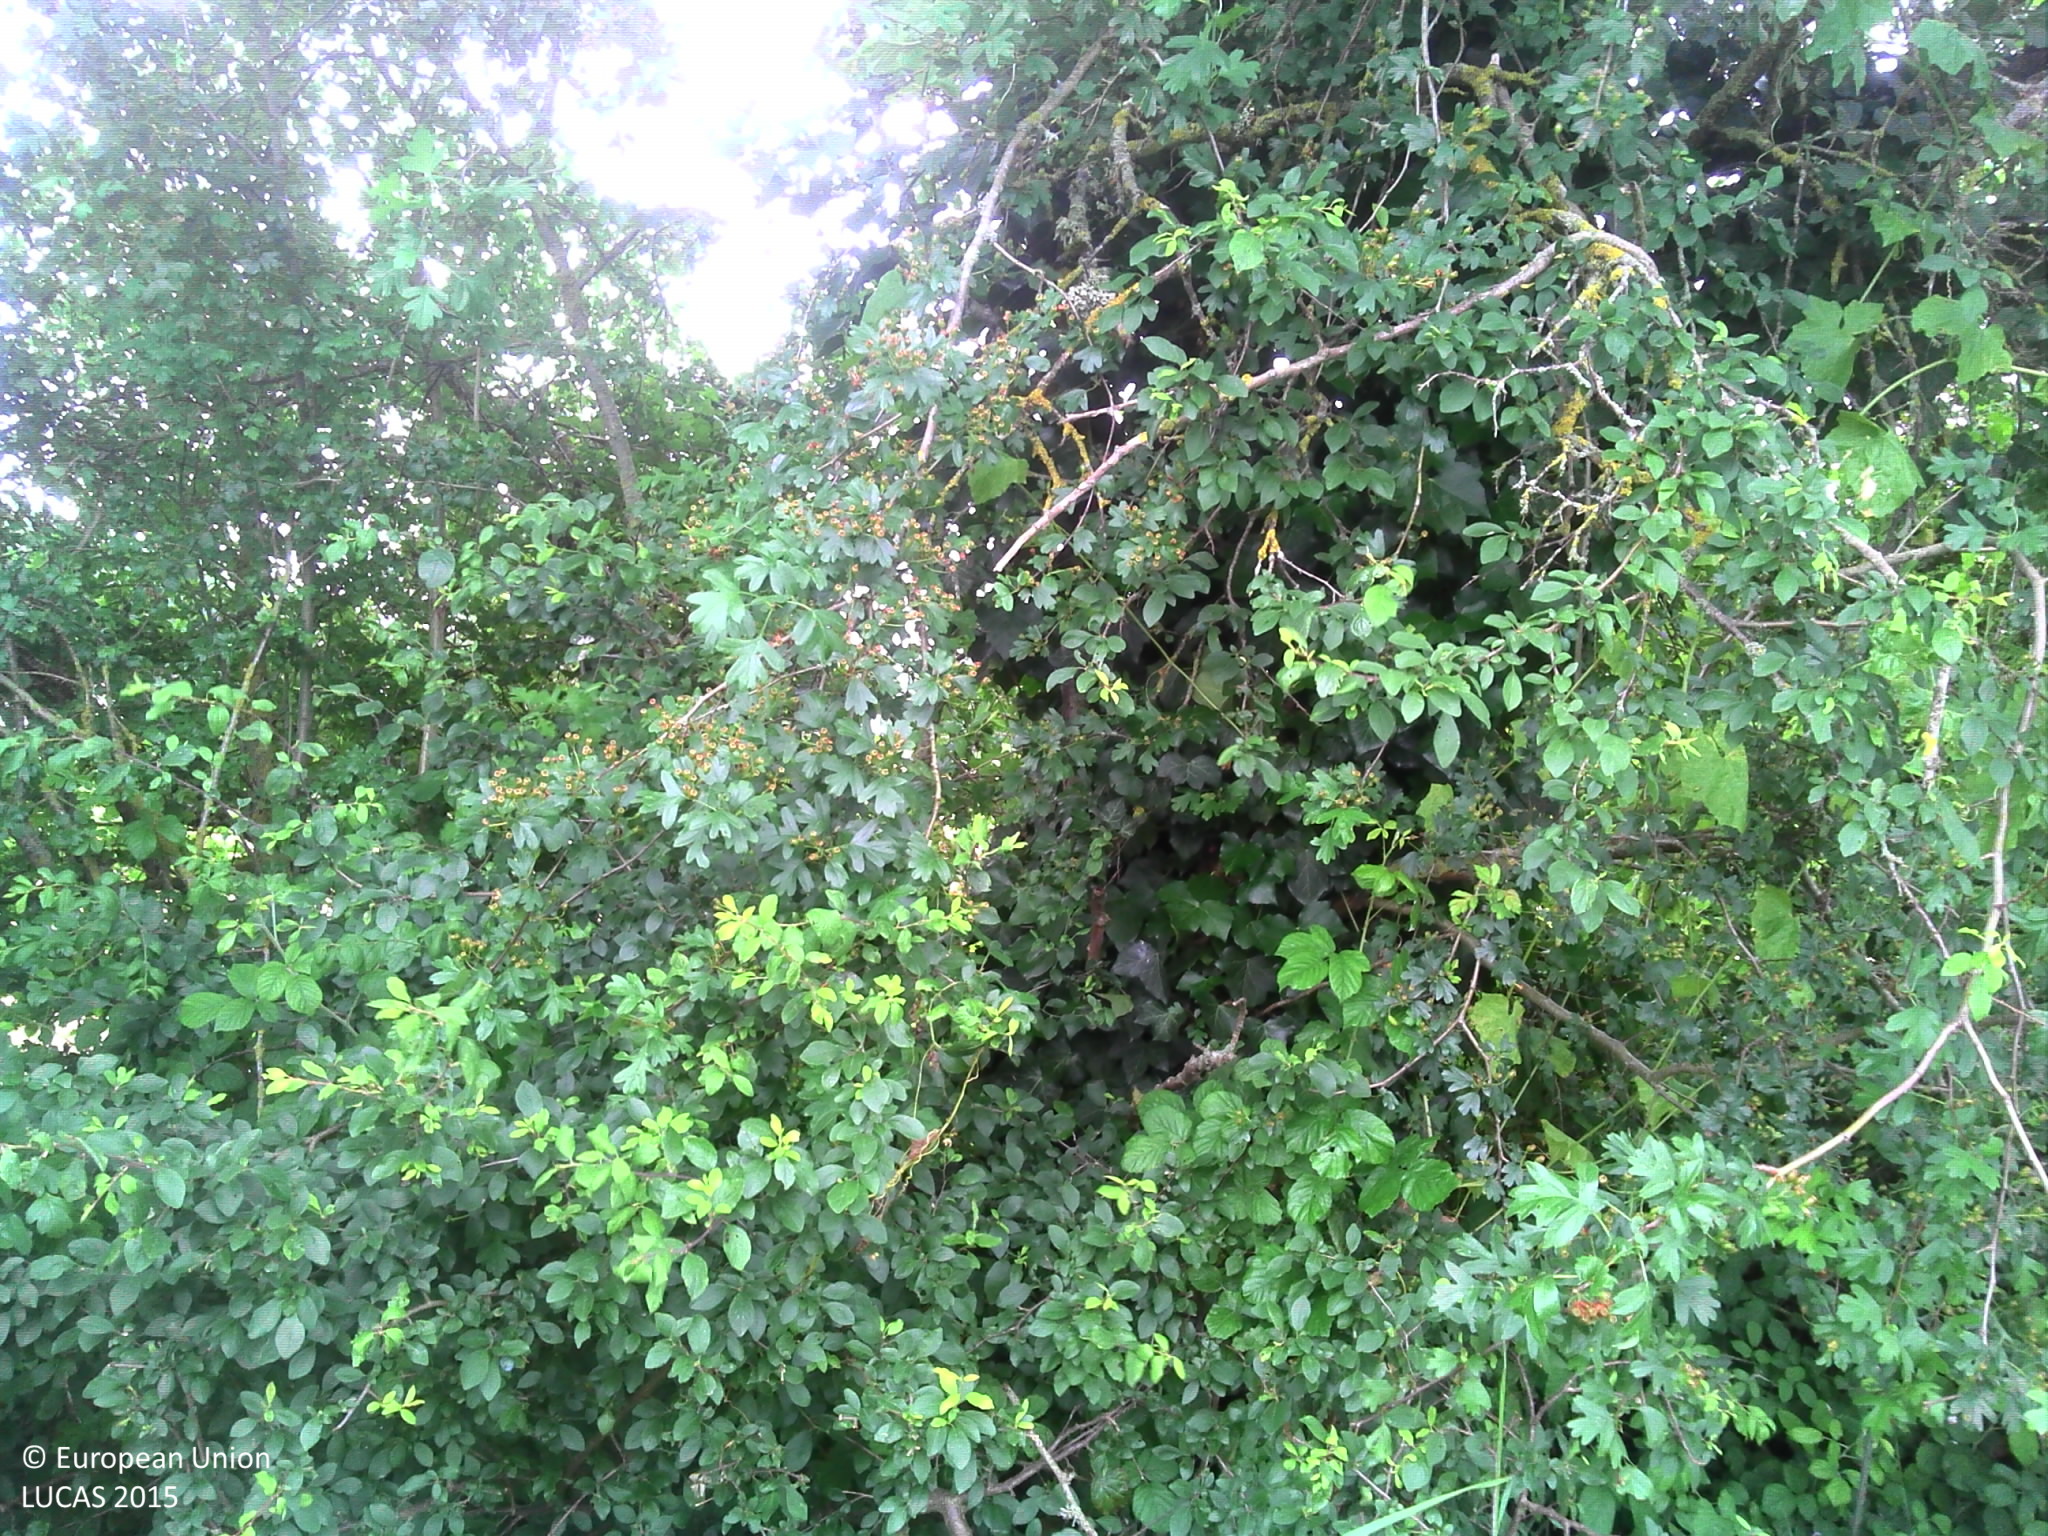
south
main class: Cropland
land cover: Triticale
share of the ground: > 75 %
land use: Agriculture (excluding fallow land and kitchen gardens)
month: May
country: FR
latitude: 43.8011
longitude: 1.7123
